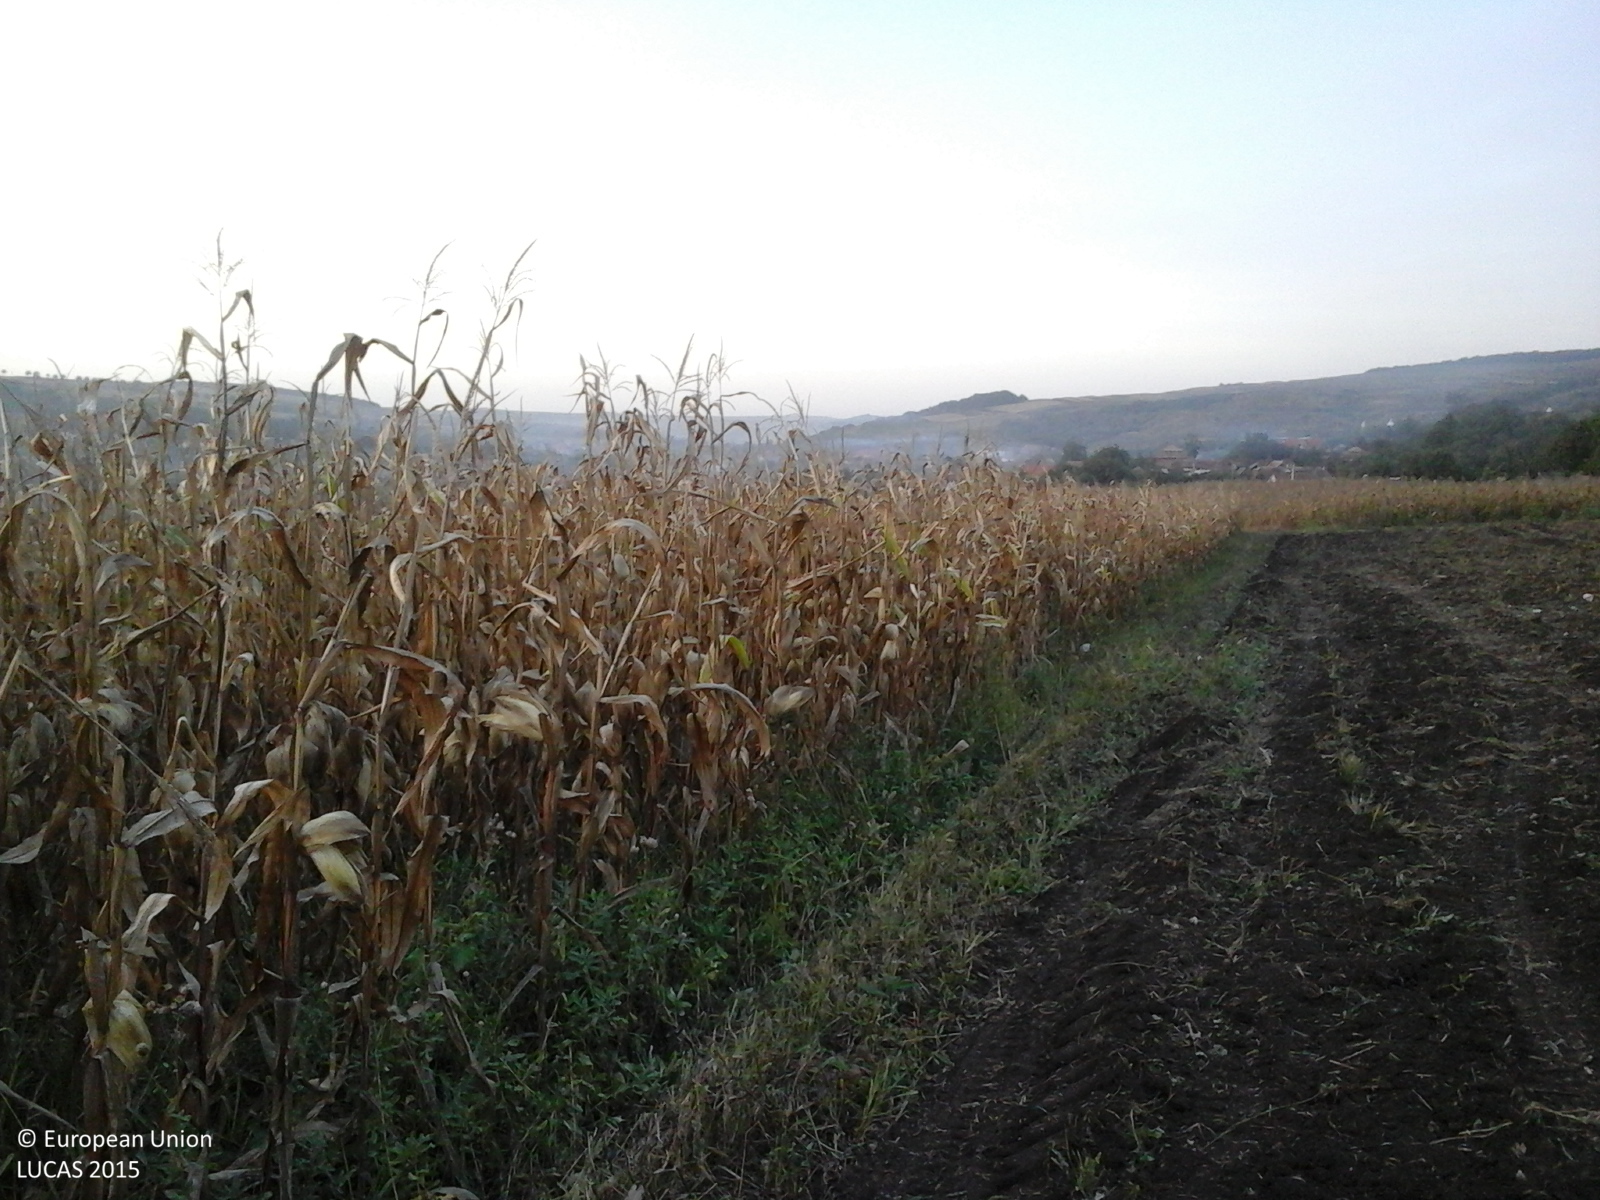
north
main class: Cropland
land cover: Potatoes
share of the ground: < 10 %
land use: Agriculture (excluding fallow land and kitchen gardens)
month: September
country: RO
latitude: 46.5758
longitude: 24.0000
